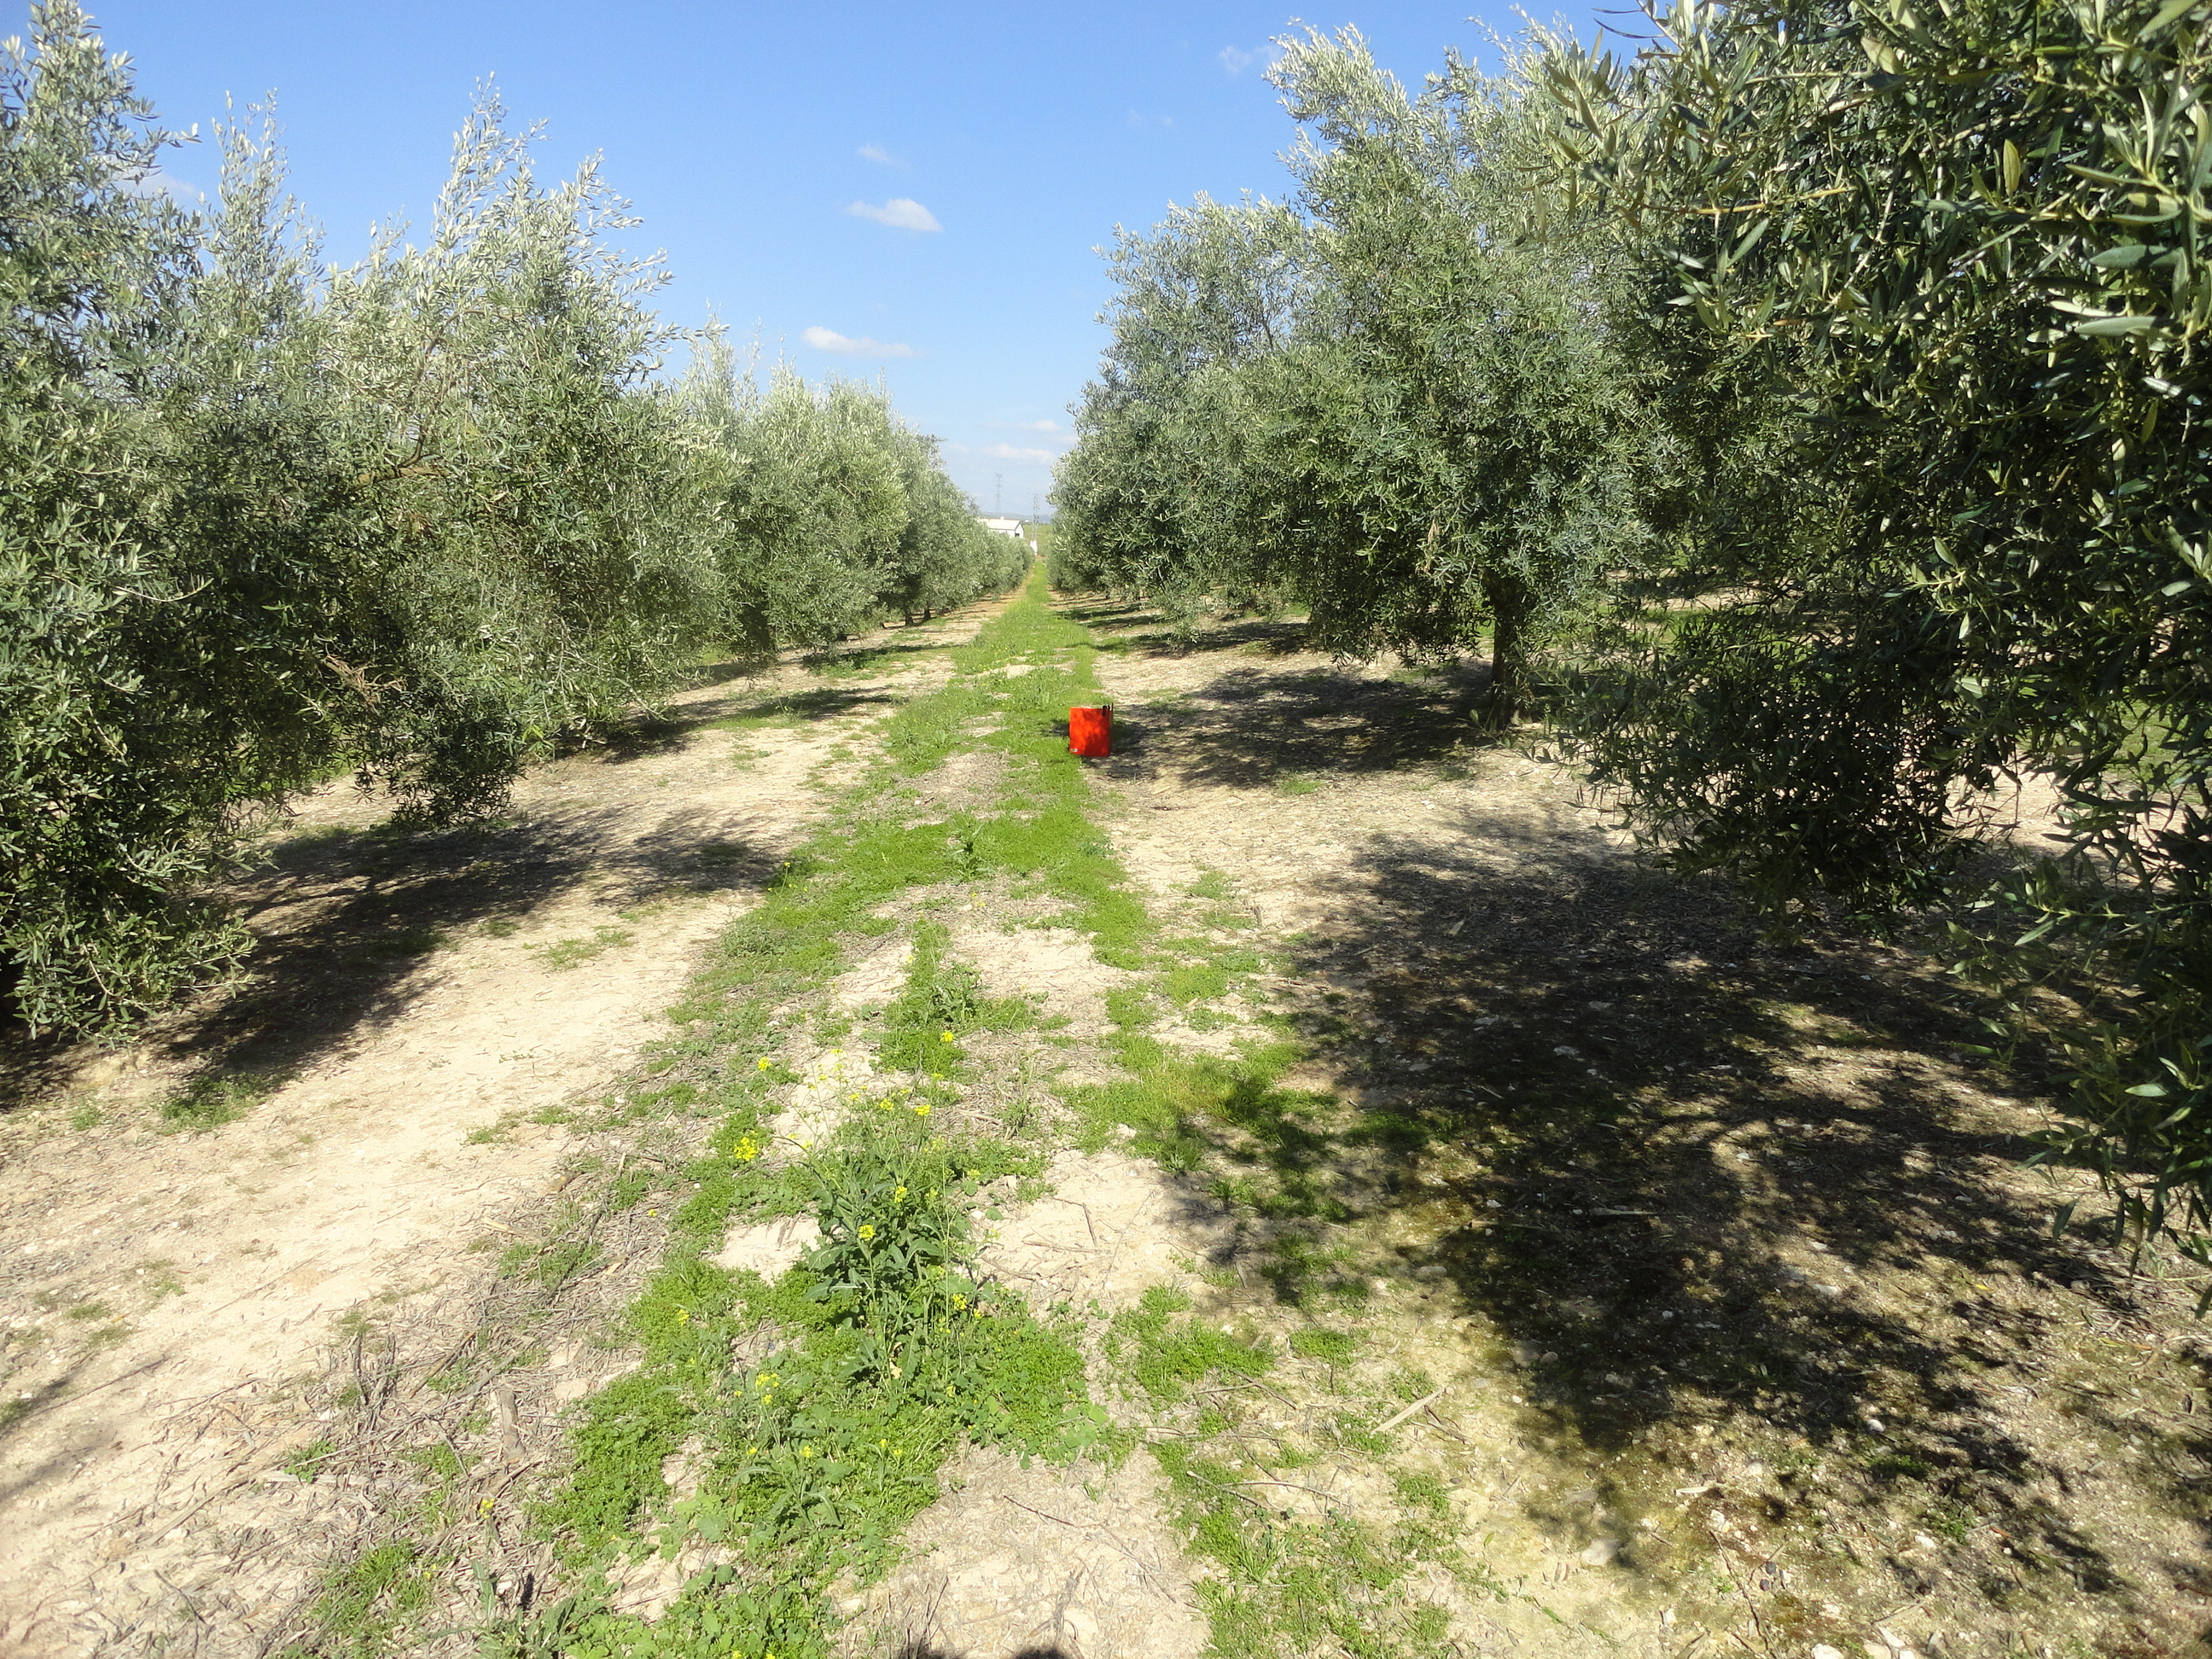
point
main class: Cropland
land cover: Olive groves
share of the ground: 50 - 75 %
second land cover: Spontaneously vegetated surfaces
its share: 25 - 50 %
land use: Agriculture (excluding fallow land and kitchen gardens)
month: April
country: ES
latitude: 37.5129
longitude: -4.4970
